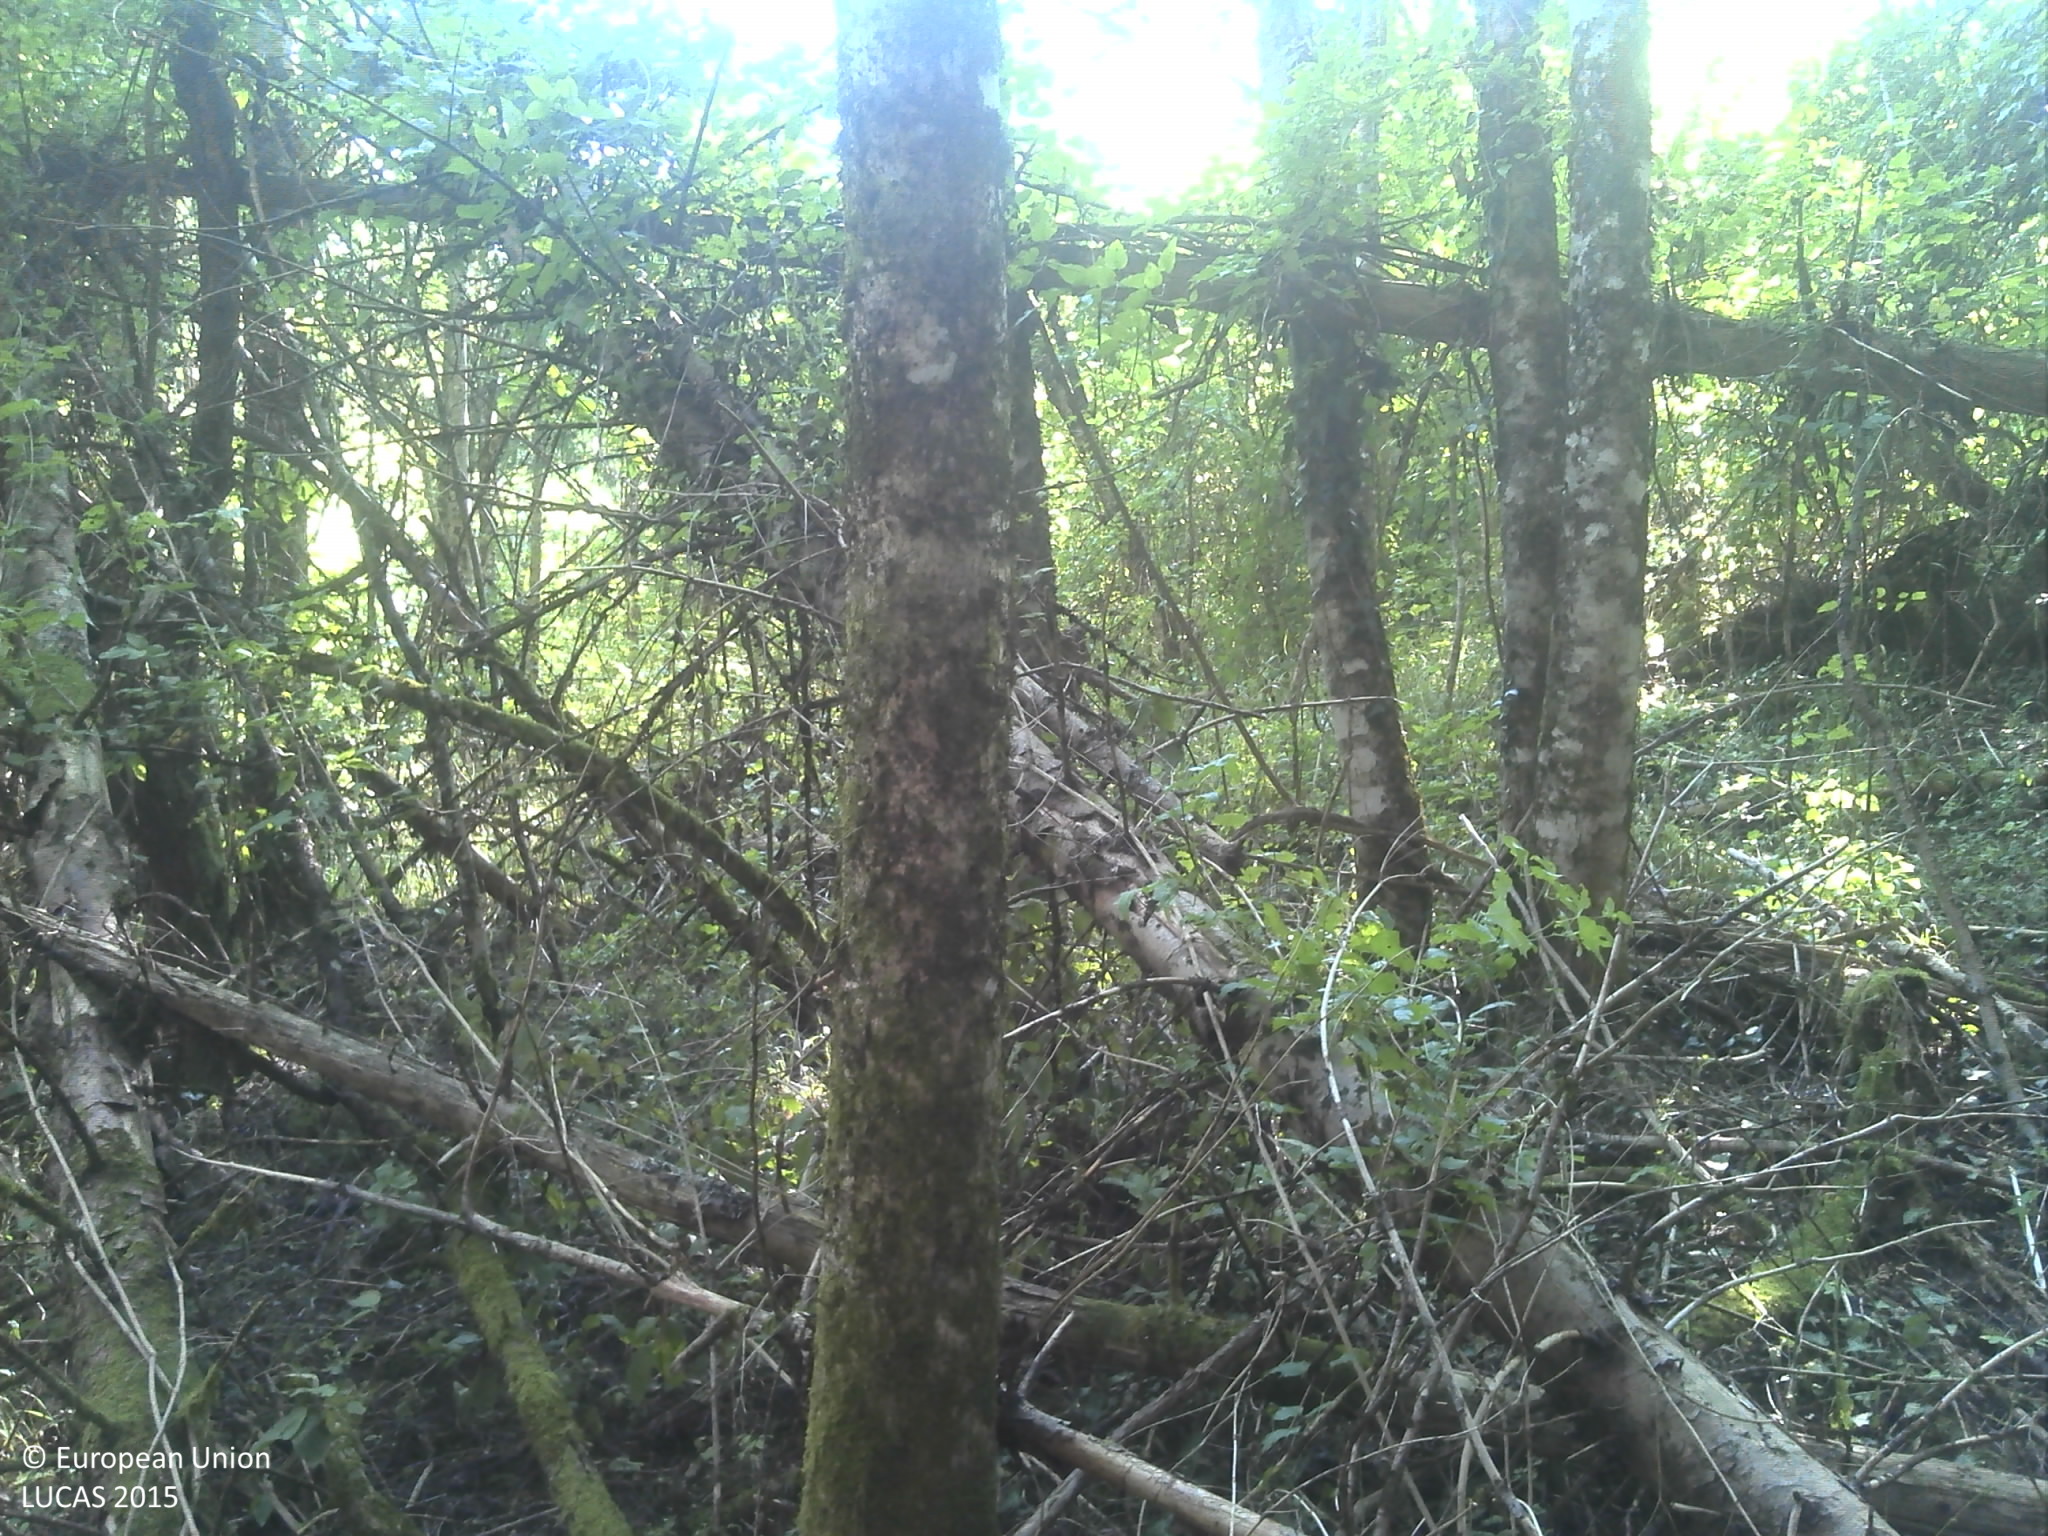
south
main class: Woodland
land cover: Spruce dominated coniferous woodland
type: alpine coniferous forest
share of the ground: > 75 %
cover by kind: coniferous forest trees 75 %, broadleaved forest trees 10 %, herbaceous plants 5 %, lichens and mosses 5 %, consolidated bare surface 5 %
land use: Semi-natural and natural areas not in use
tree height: > 5 m
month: August
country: HR
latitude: 44.6872
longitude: 15.2552
